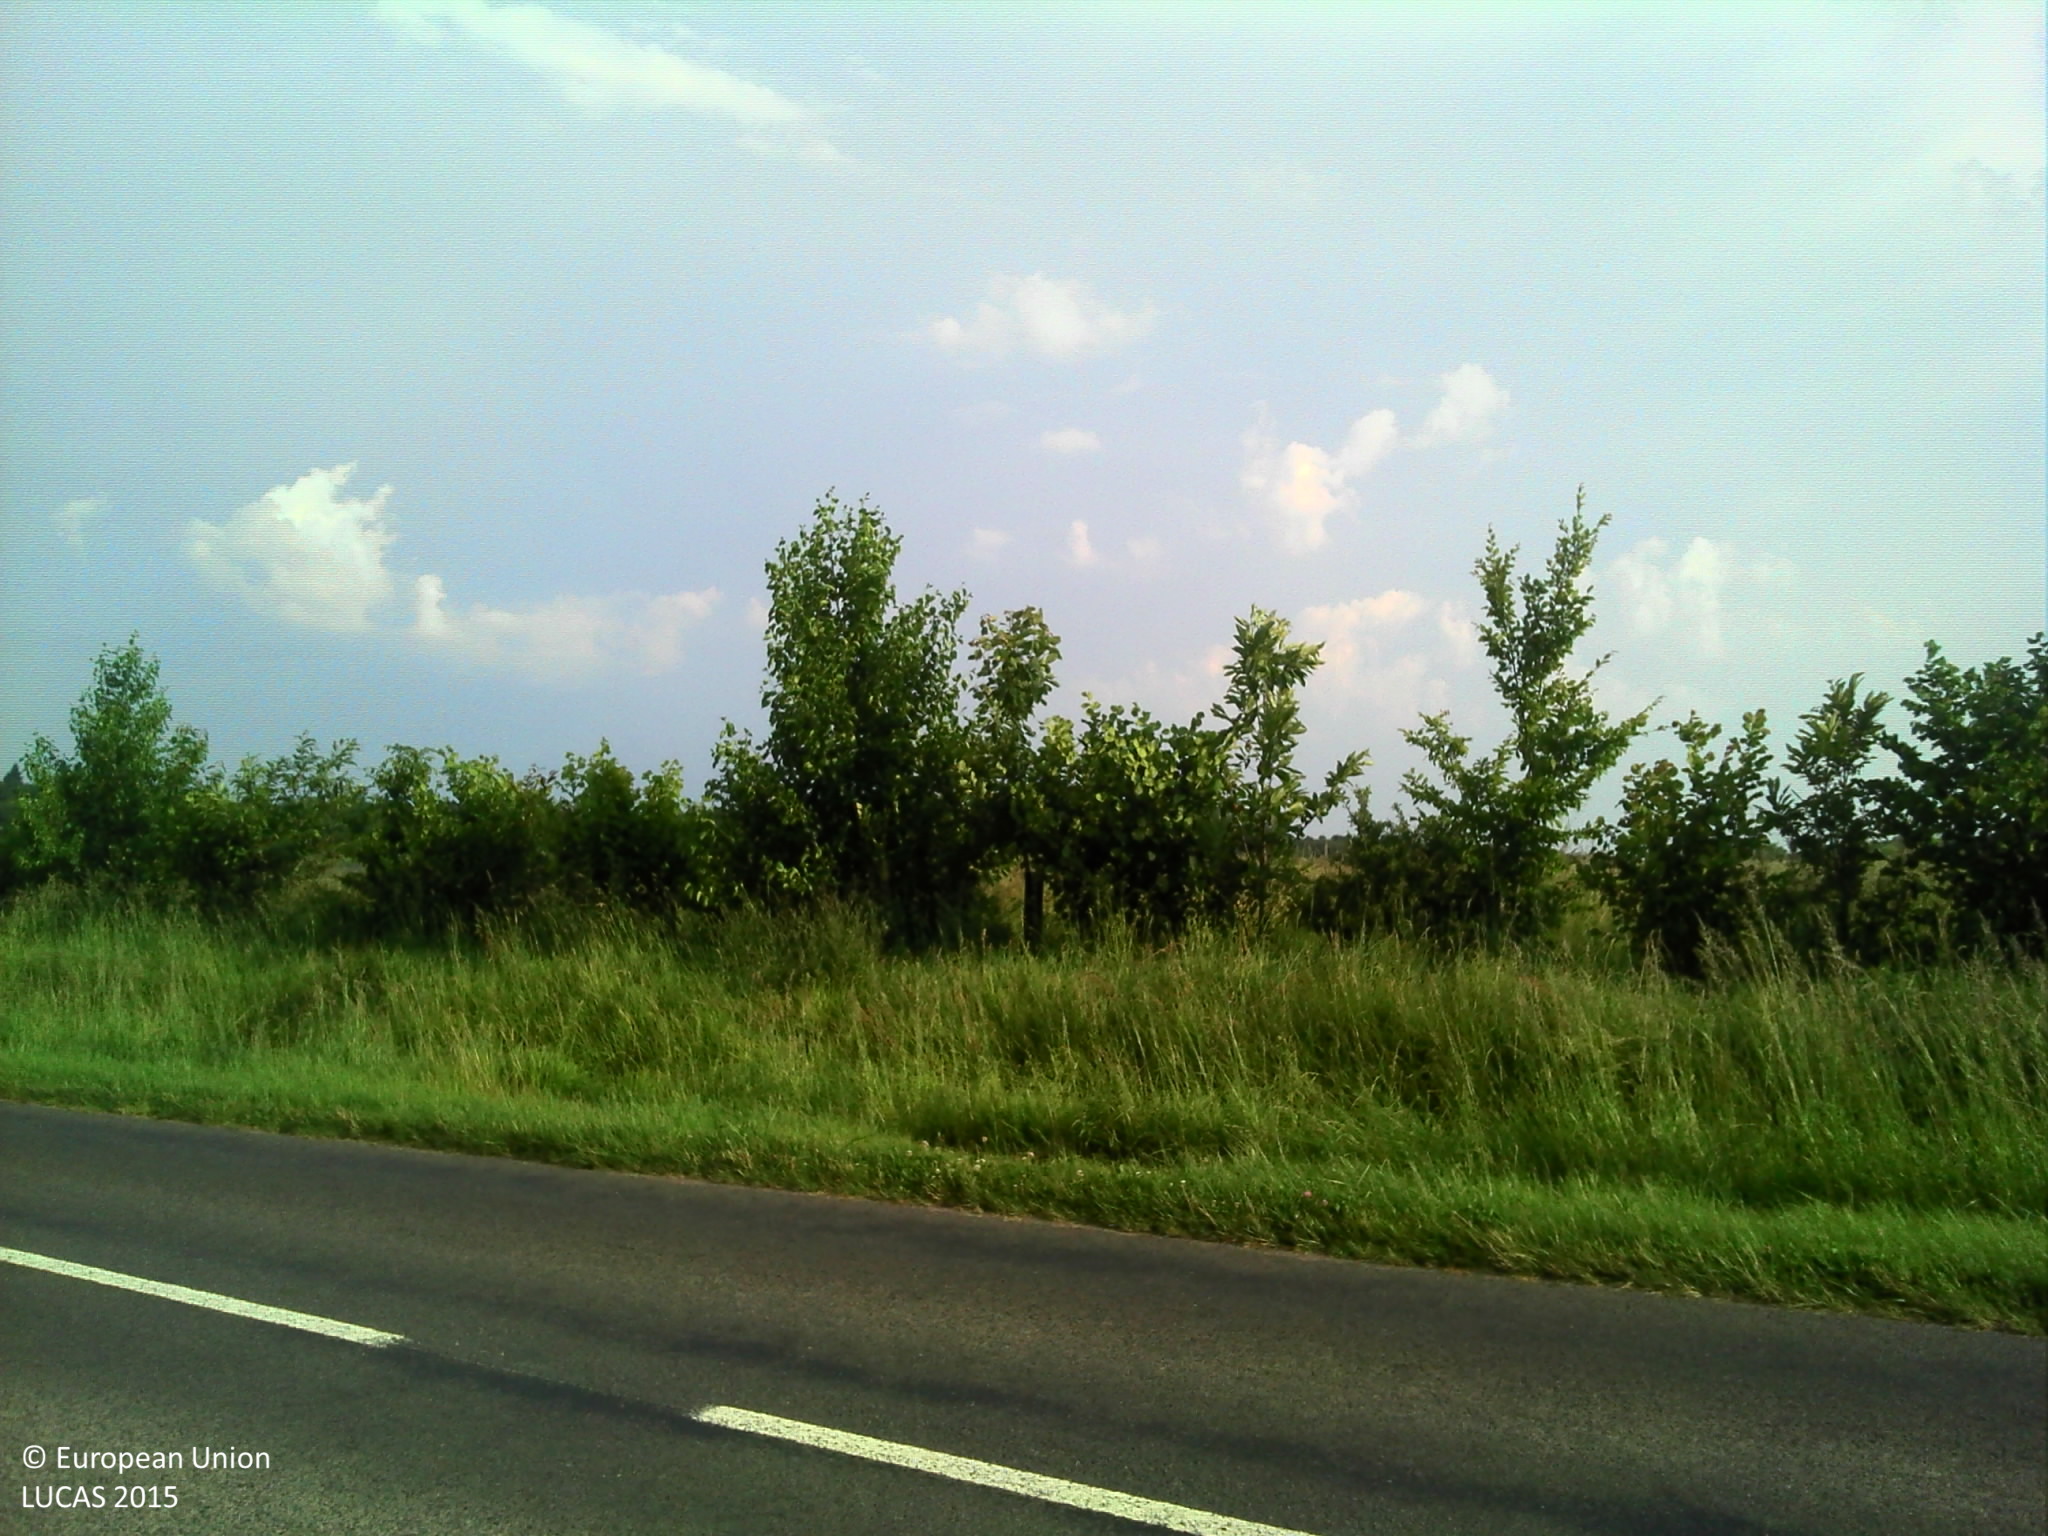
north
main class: Cropland
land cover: Maize
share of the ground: < 10 %
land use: Agriculture (excluding fallow land and kitchen gardens)
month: June
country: FR
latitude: 47.9310
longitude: 0.0006
